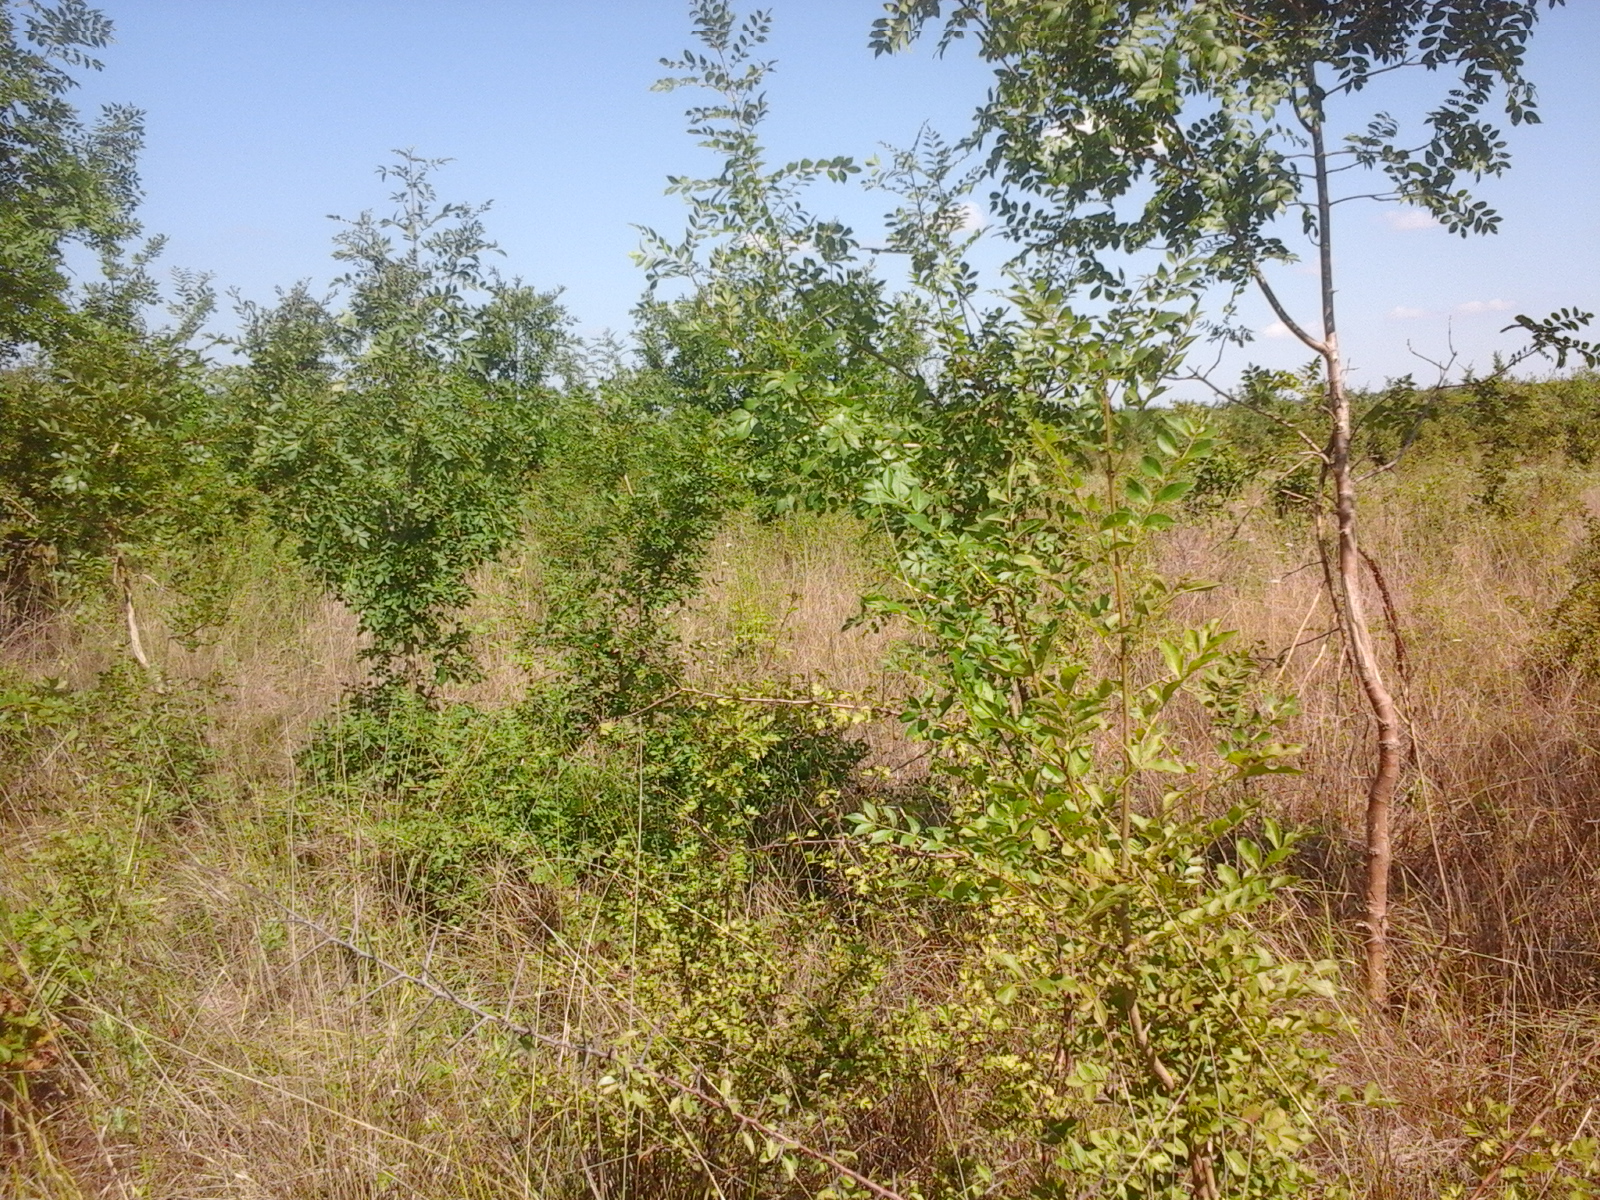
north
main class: Grassland
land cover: Grassland with sparse tree/shrub cover
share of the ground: > 75 %
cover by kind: herbaceous plants 95 %, broadleaved forest trees 5 %
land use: Fallow land
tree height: > 5 m
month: August
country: RO
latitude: 46.1201
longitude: 21.0689
